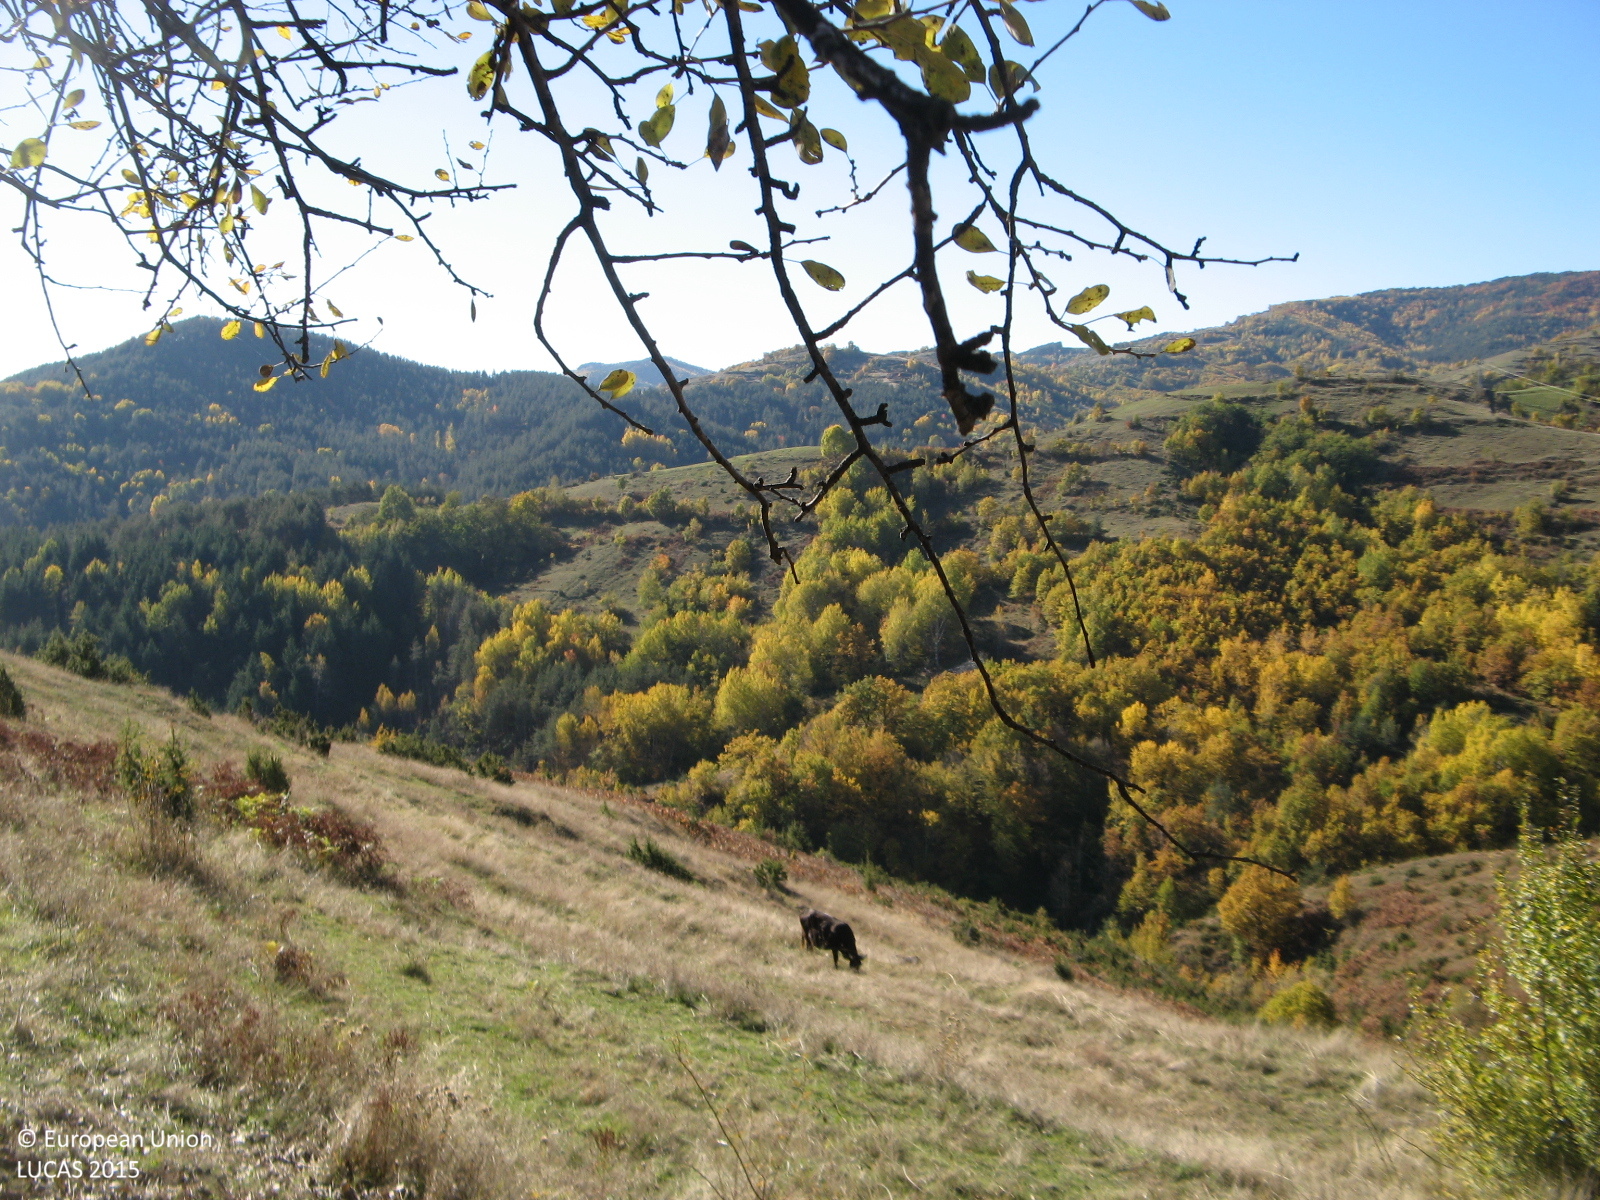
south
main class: Grassland
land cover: Grassland with sparse tree/shrub cover
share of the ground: > 75 %
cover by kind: herbaceous plants 85 %, shrubs 10 %, broadleaved forest trees 5 %
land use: Agriculture (excluding fallow land and kitchen gardens)
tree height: > 5 m
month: November
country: BG
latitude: 41.6504
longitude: 25.1703
